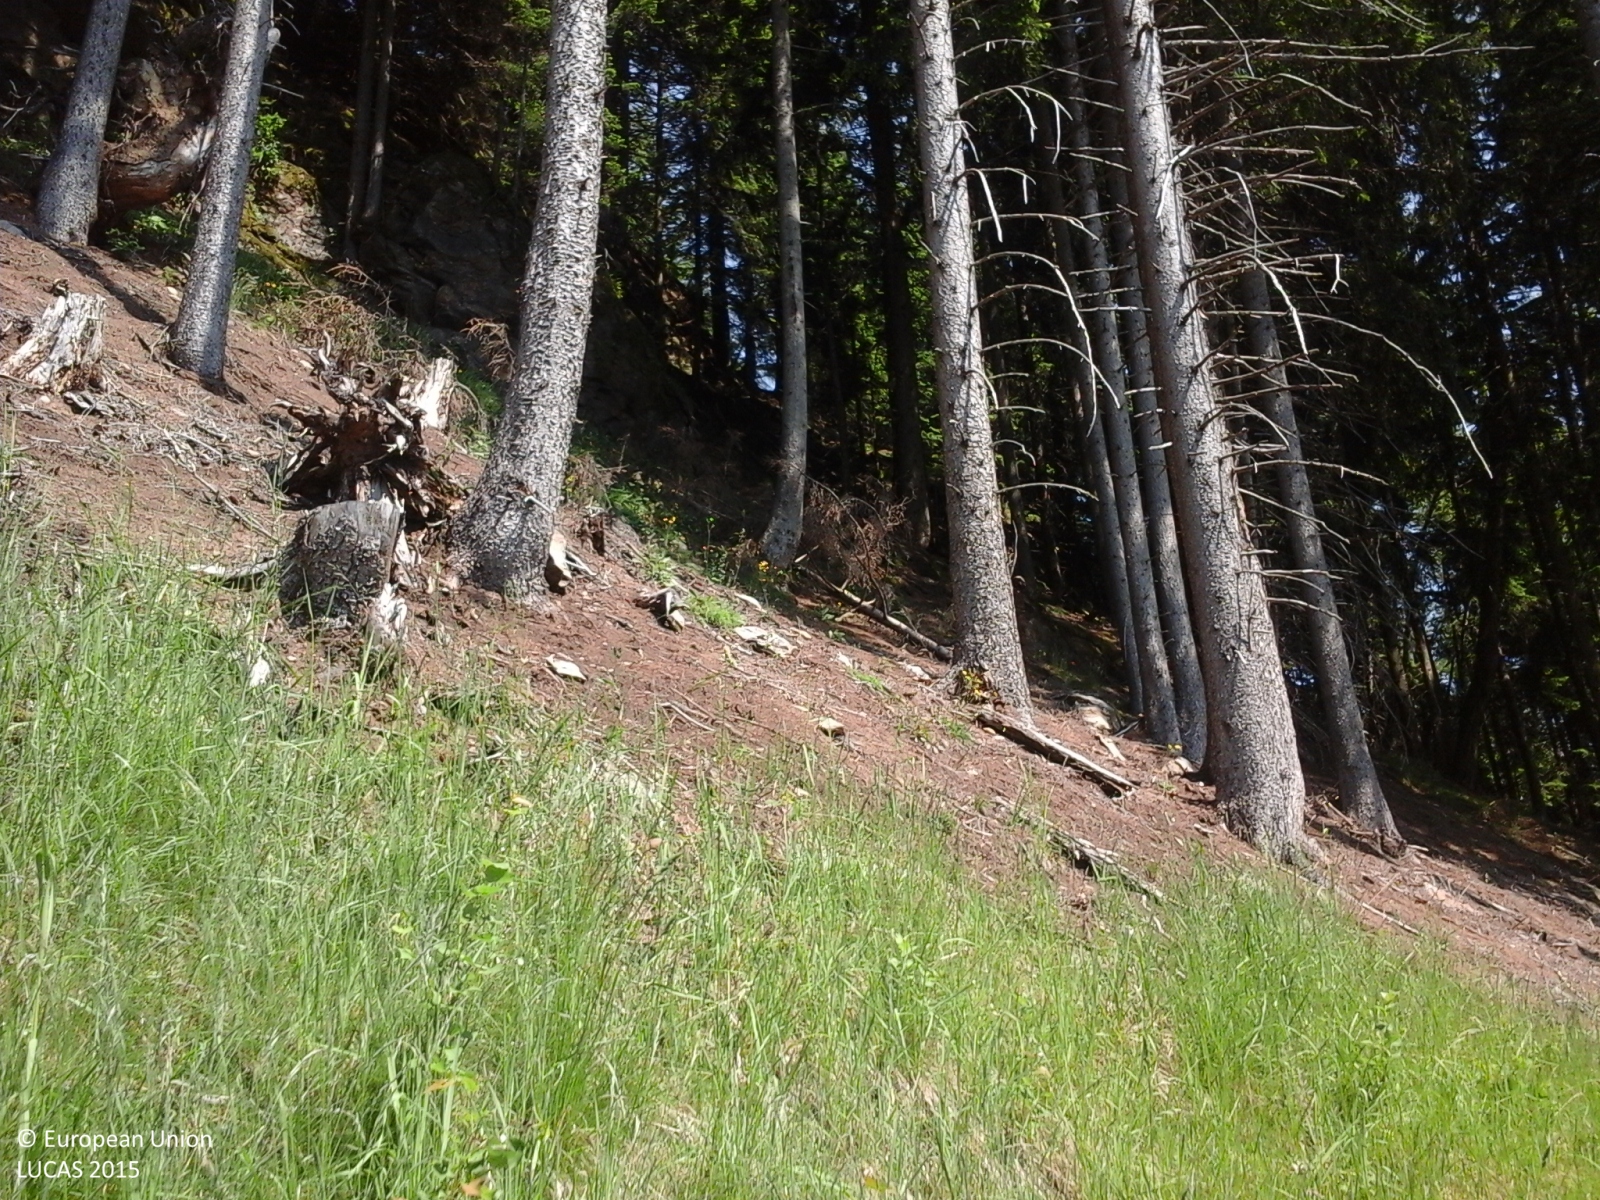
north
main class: Woodland
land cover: Spruce dominated coniferous woodland
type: alpine coniferous forest
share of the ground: > 75 %
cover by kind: coniferous forest trees 100 %
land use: Forestry
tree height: > 5 m
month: June
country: IT
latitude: 46.7589
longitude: 11.1901
